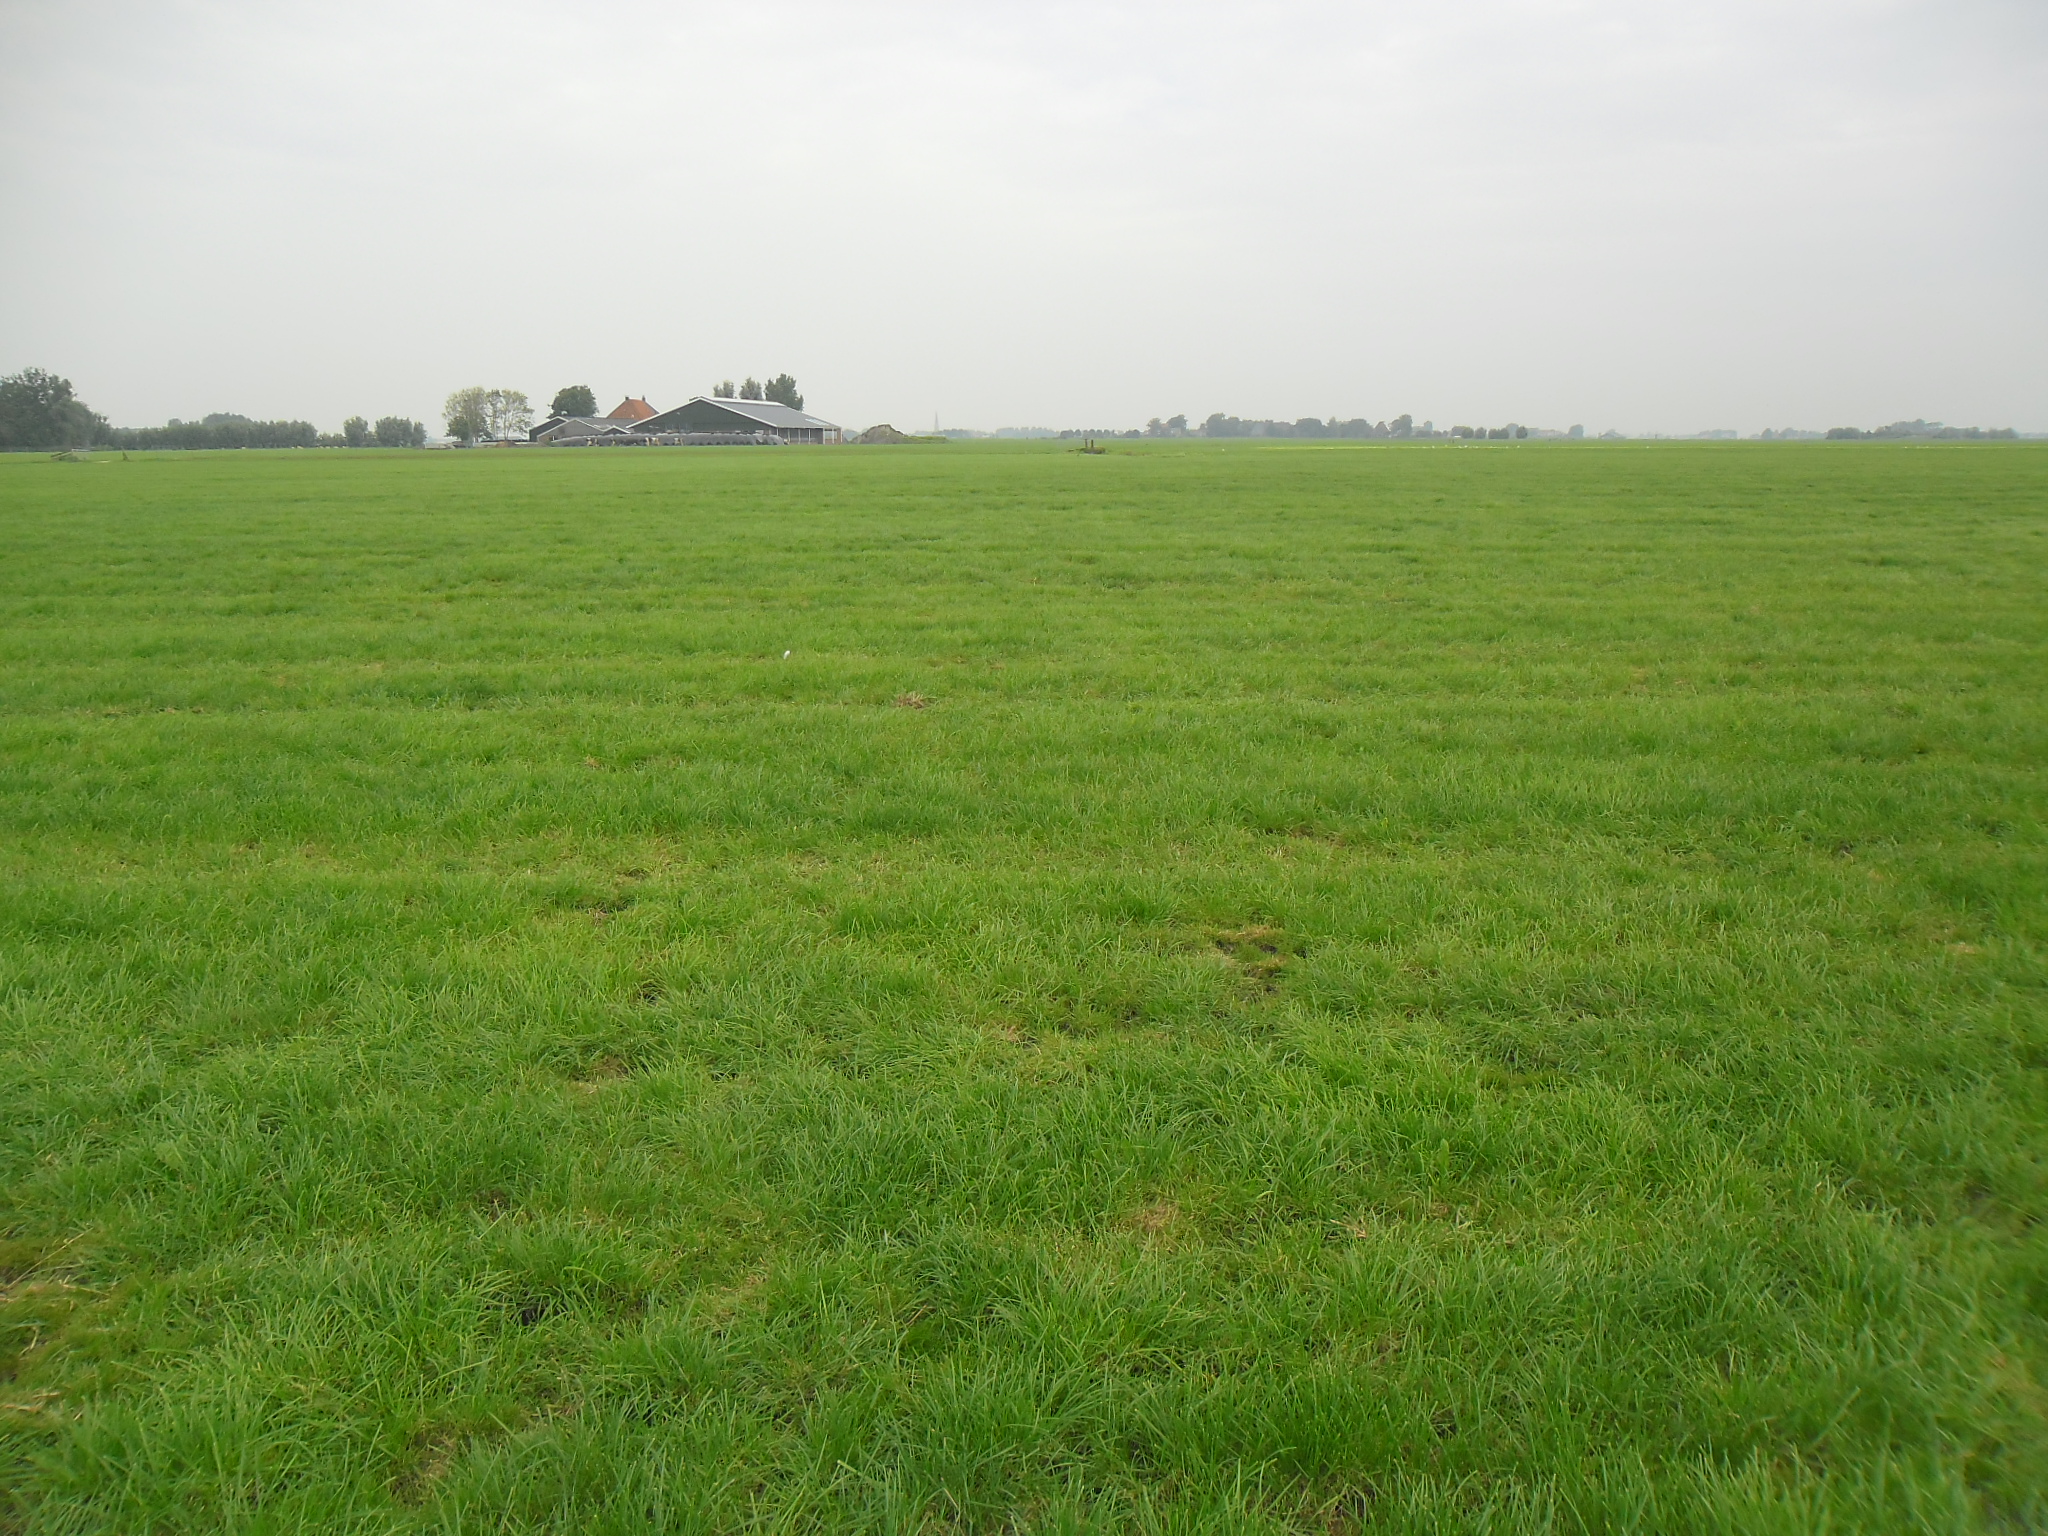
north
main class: Grassland
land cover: Grassland without tree/shrub cover
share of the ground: > 75 %
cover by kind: herbaceous plants 100 %
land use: Agriculture (excluding fallow land and kitchen gardens)
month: August
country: NL
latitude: 53.1226
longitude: 5.5608
